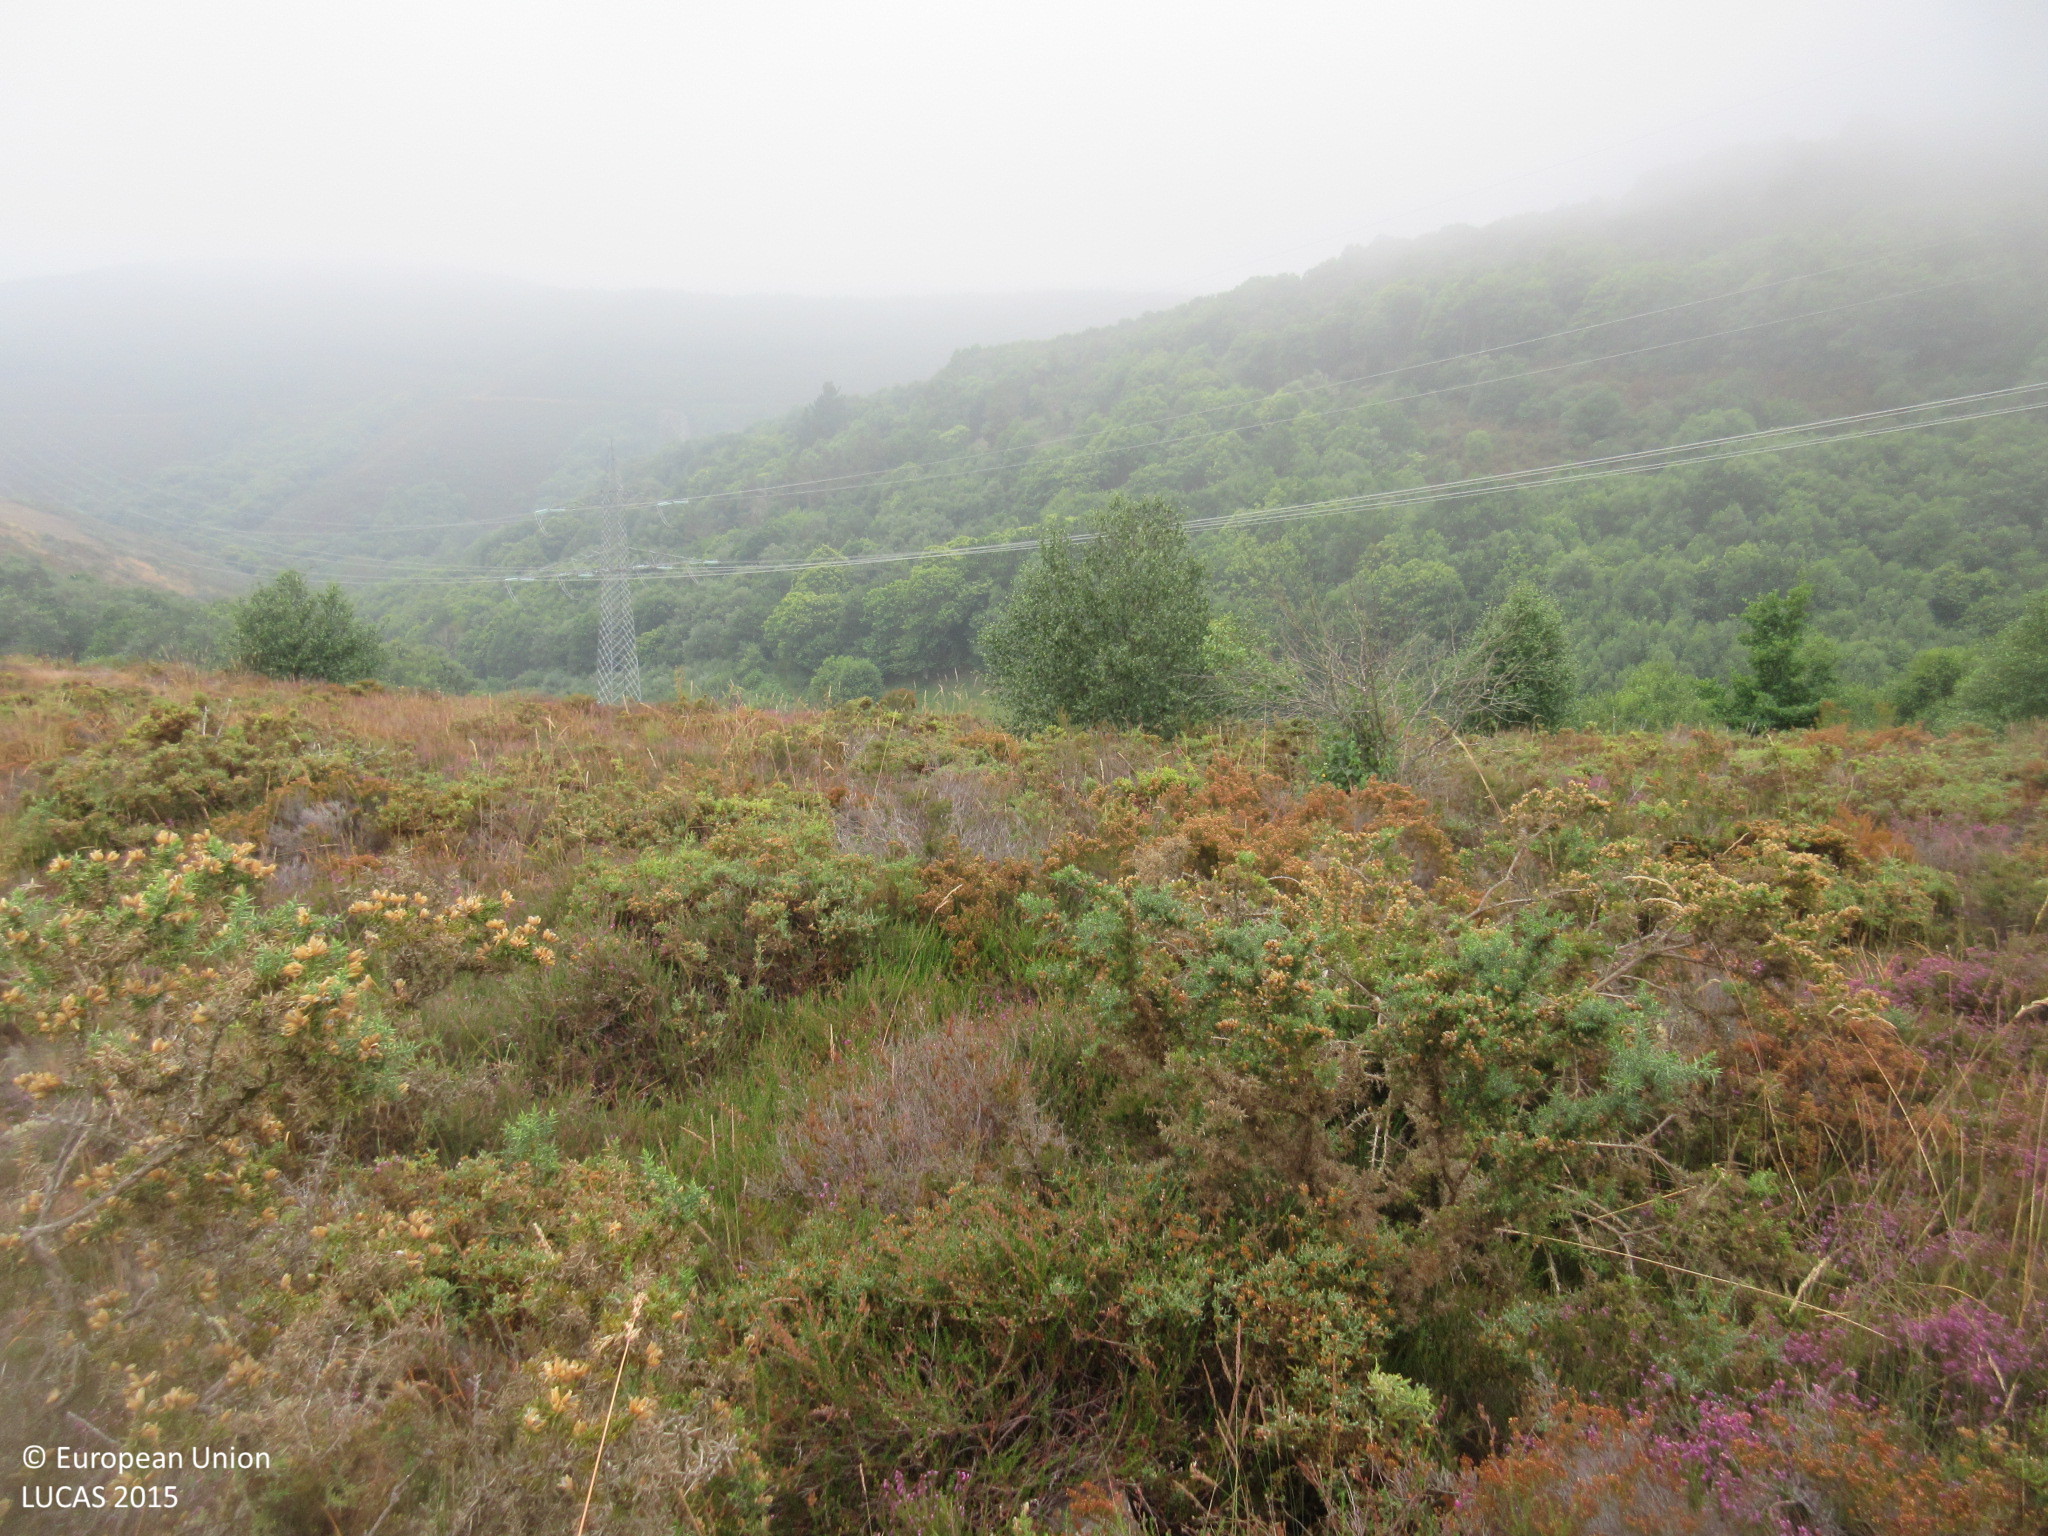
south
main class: Shrubland
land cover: Shrubland with sparse tree cover
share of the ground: > 75 %
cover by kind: shrubs 95 %, broadleaved forest trees 5 %
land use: Semi-natural and natural areas not in use
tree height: > 5 m
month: June
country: ES
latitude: 42.8959
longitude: -7.1228
